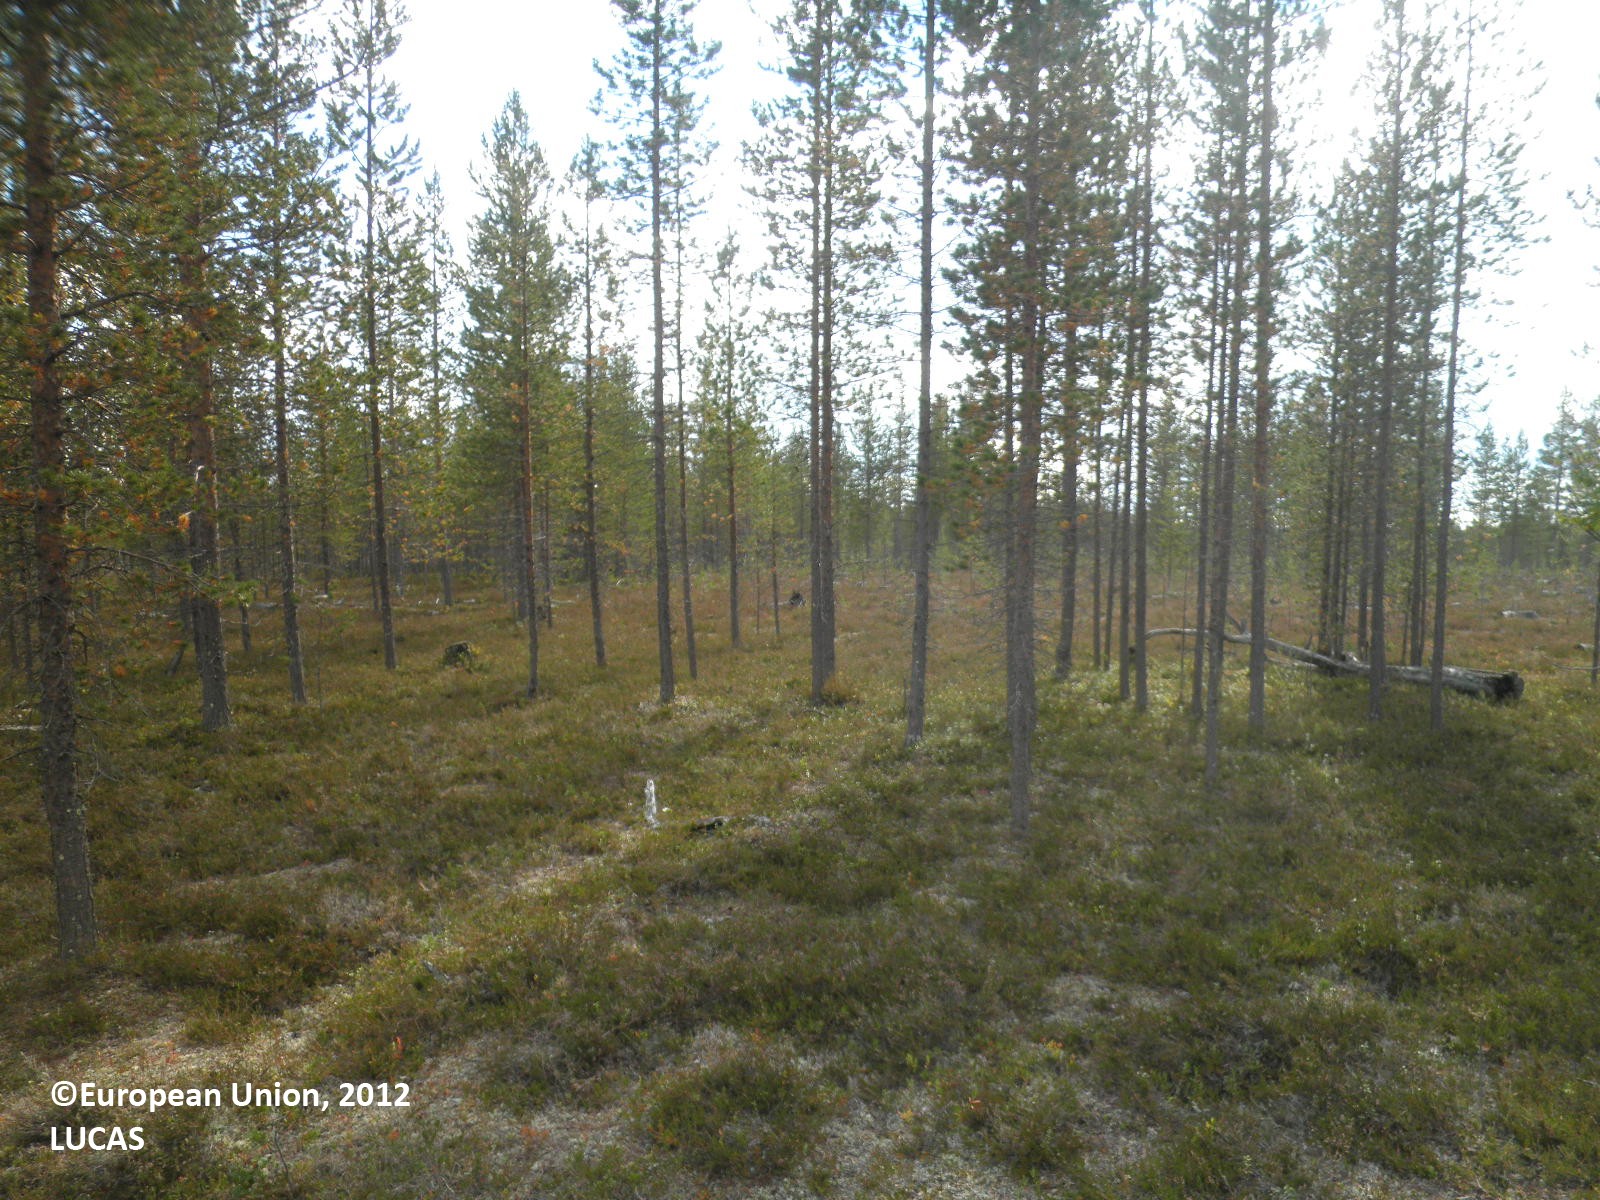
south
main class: Woodland
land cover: Pine dominated coniferous woodland
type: boreal forest
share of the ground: 25 - 50 %
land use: Forestry
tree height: > 5 m
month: August
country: FI
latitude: 67.9876
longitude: 28.2086
